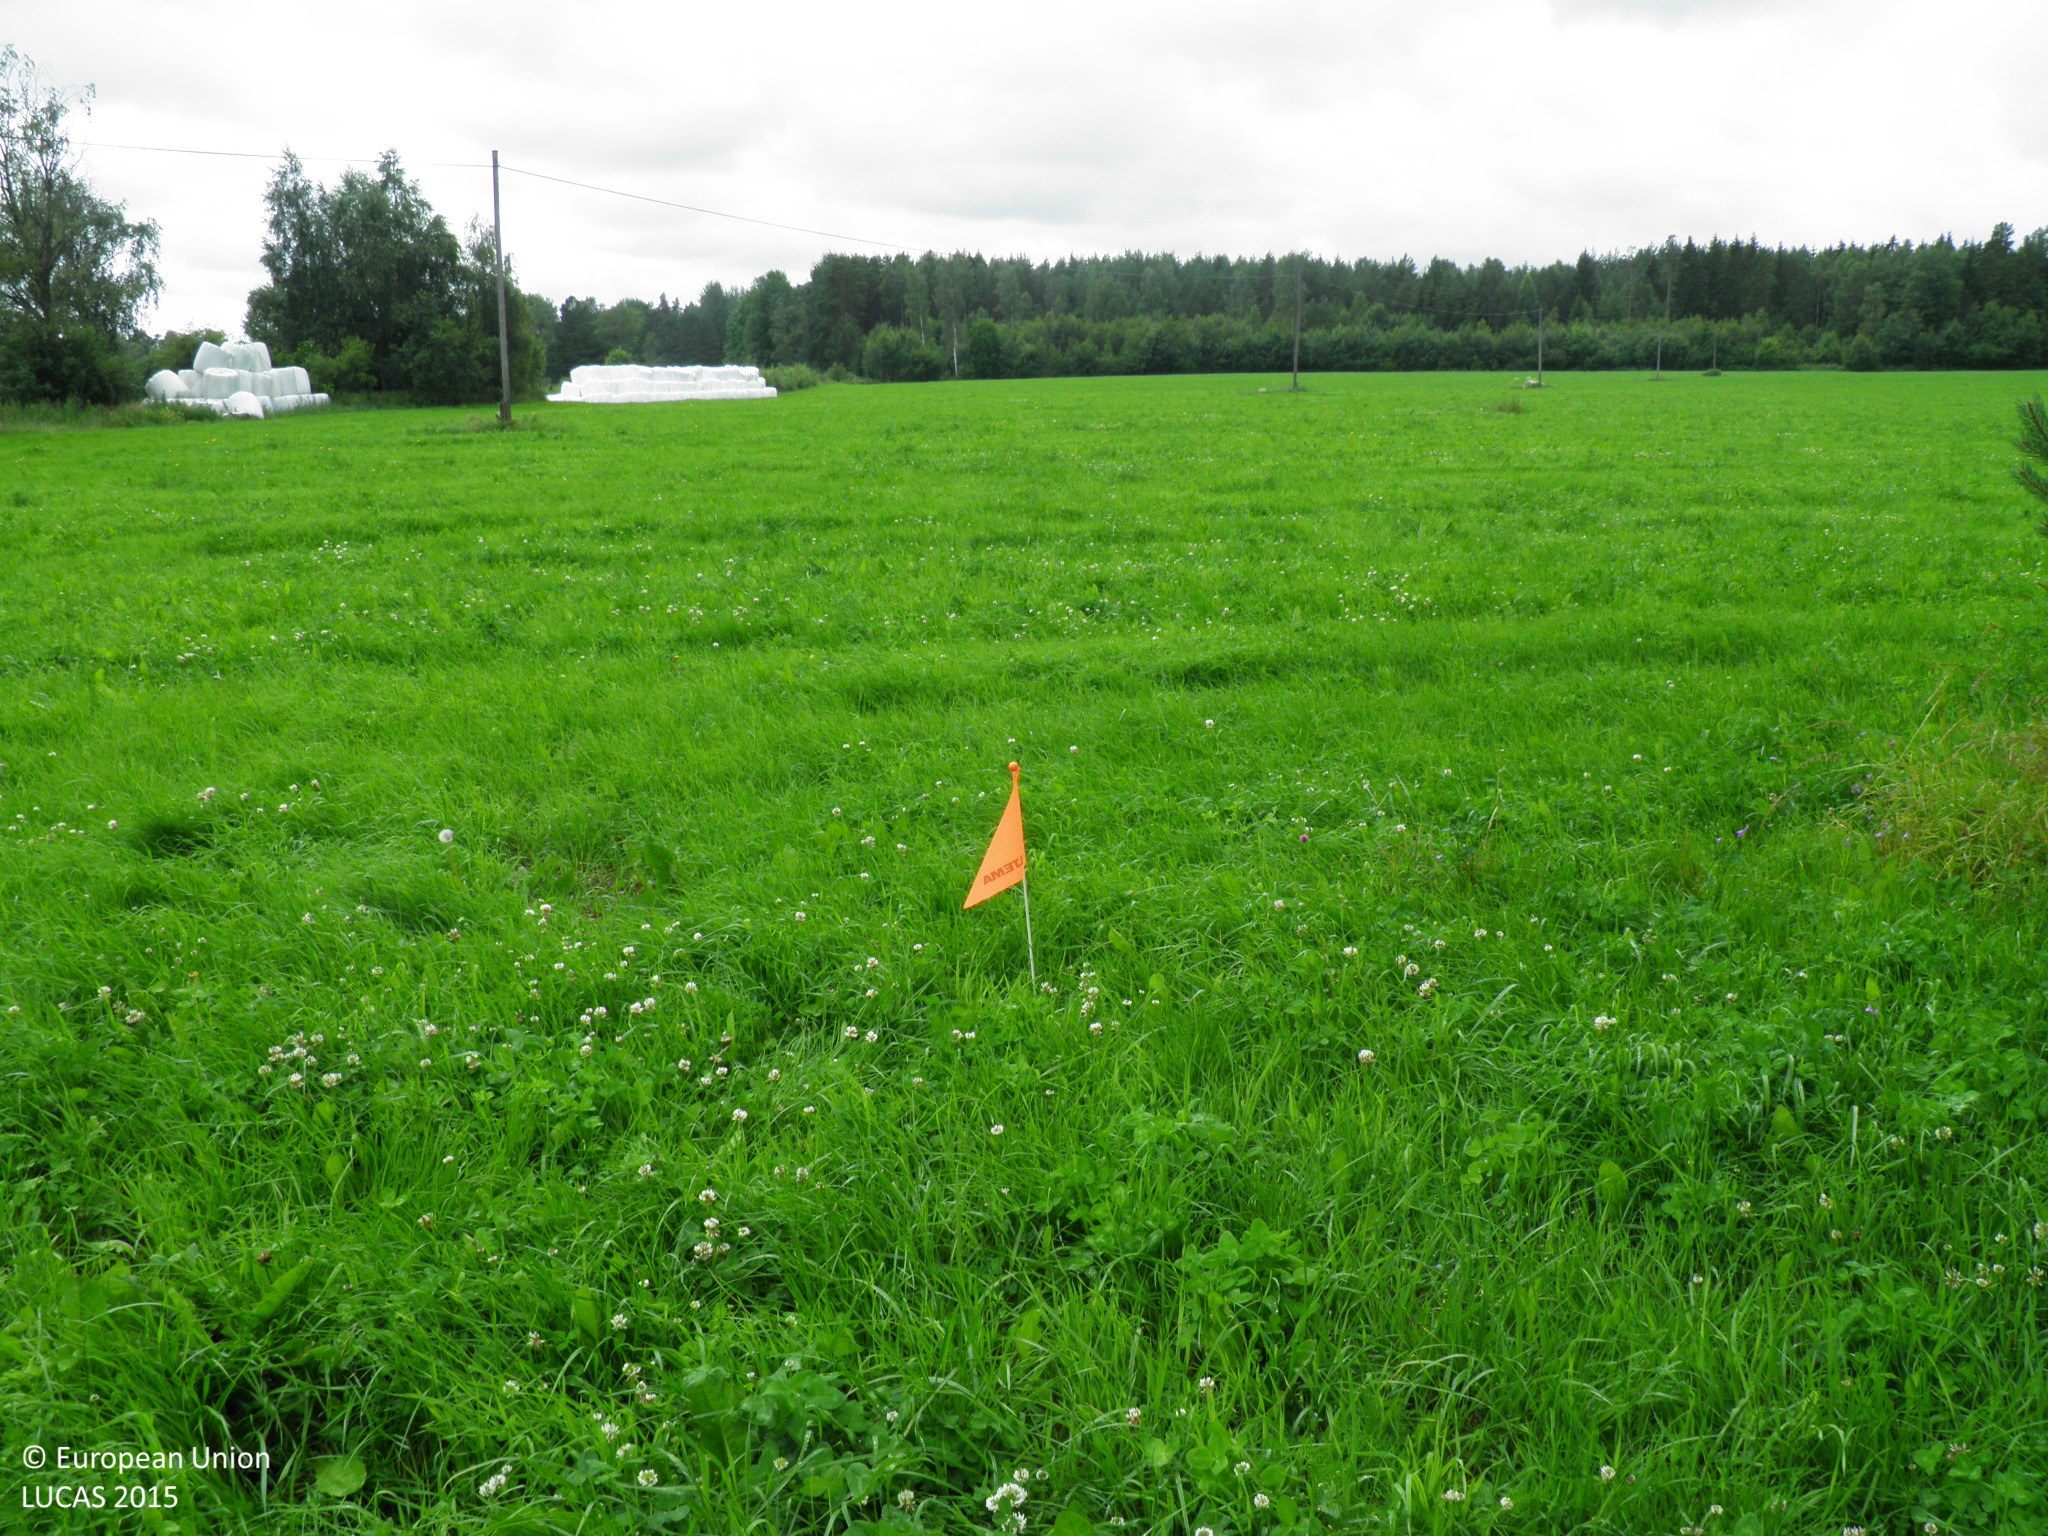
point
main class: Cropland
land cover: Temporary grasslands
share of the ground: > 75 %
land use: Agriculture (excluding fallow land and kitchen gardens)
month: July
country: FI
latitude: 60.6512
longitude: 21.5614
